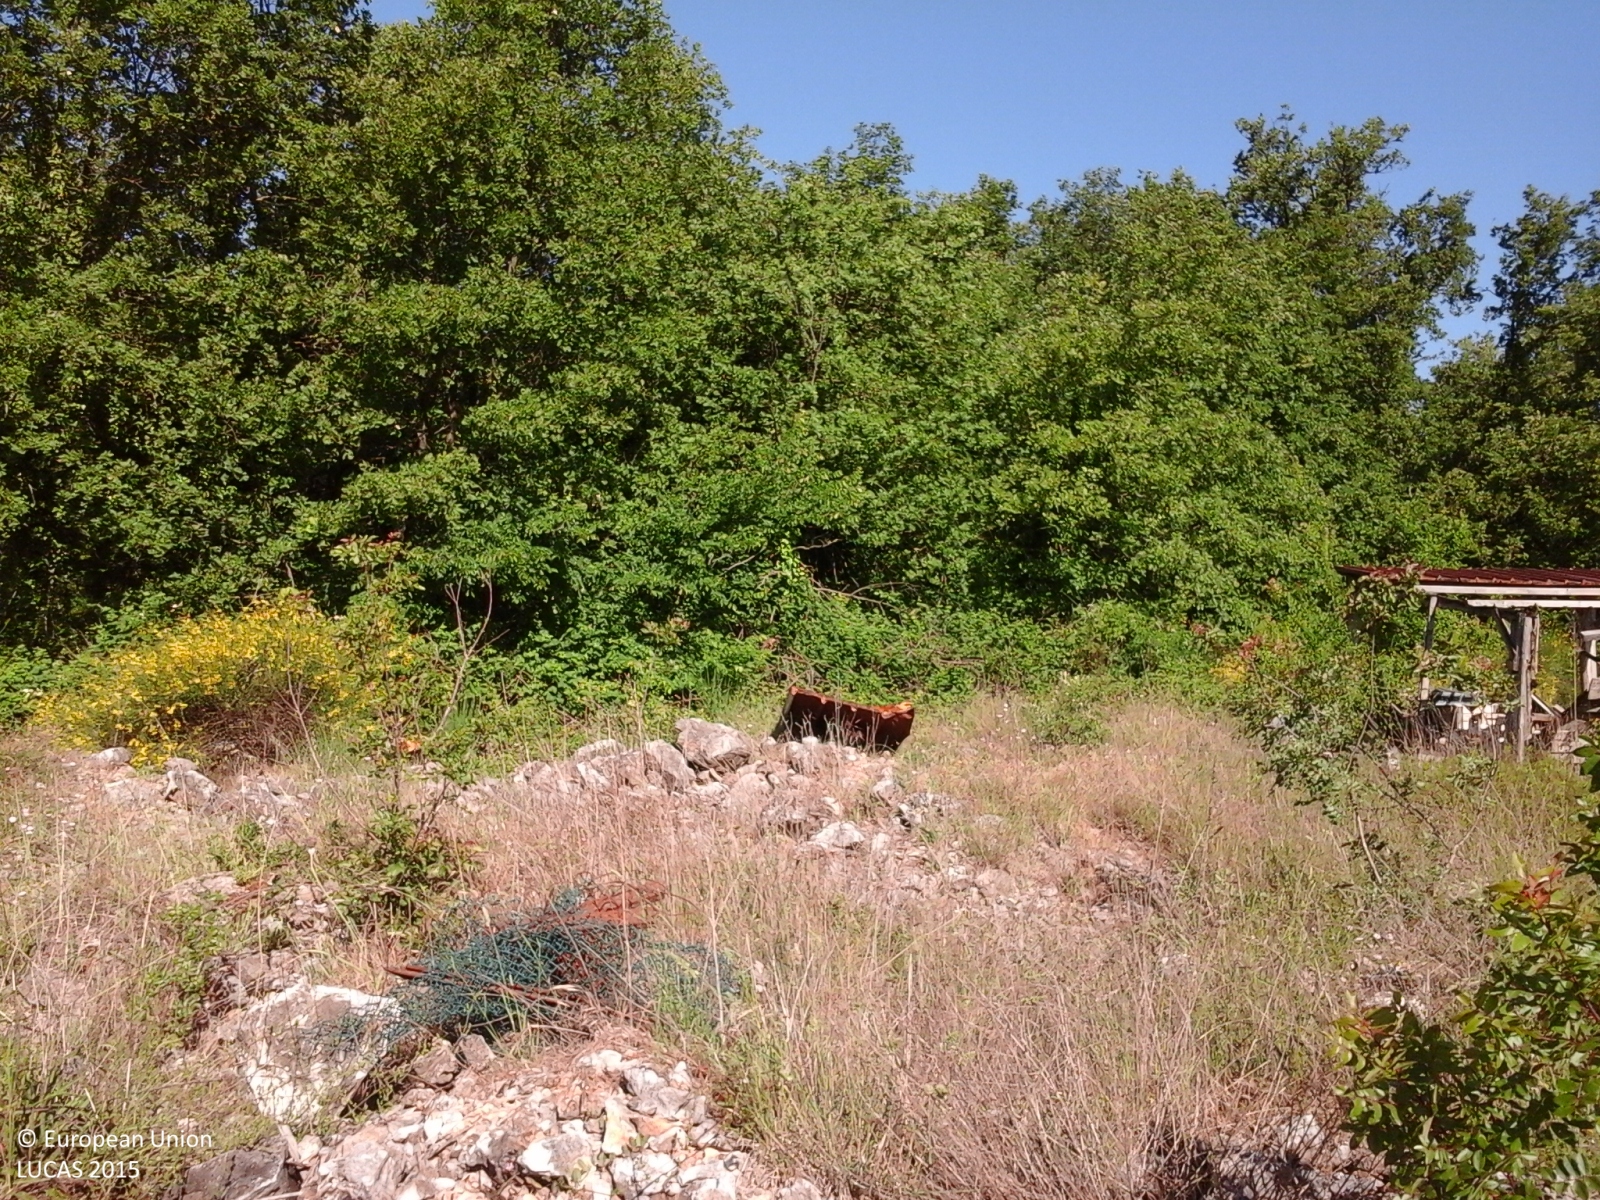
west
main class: Grassland
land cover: Grassland without tree/shrub cover
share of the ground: 50 - 75 %
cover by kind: herbaceous plants 70 %, unconsolidated bare surface 30 %
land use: Abandoned areas
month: May
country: IT
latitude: 41.6744
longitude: 13.4106
